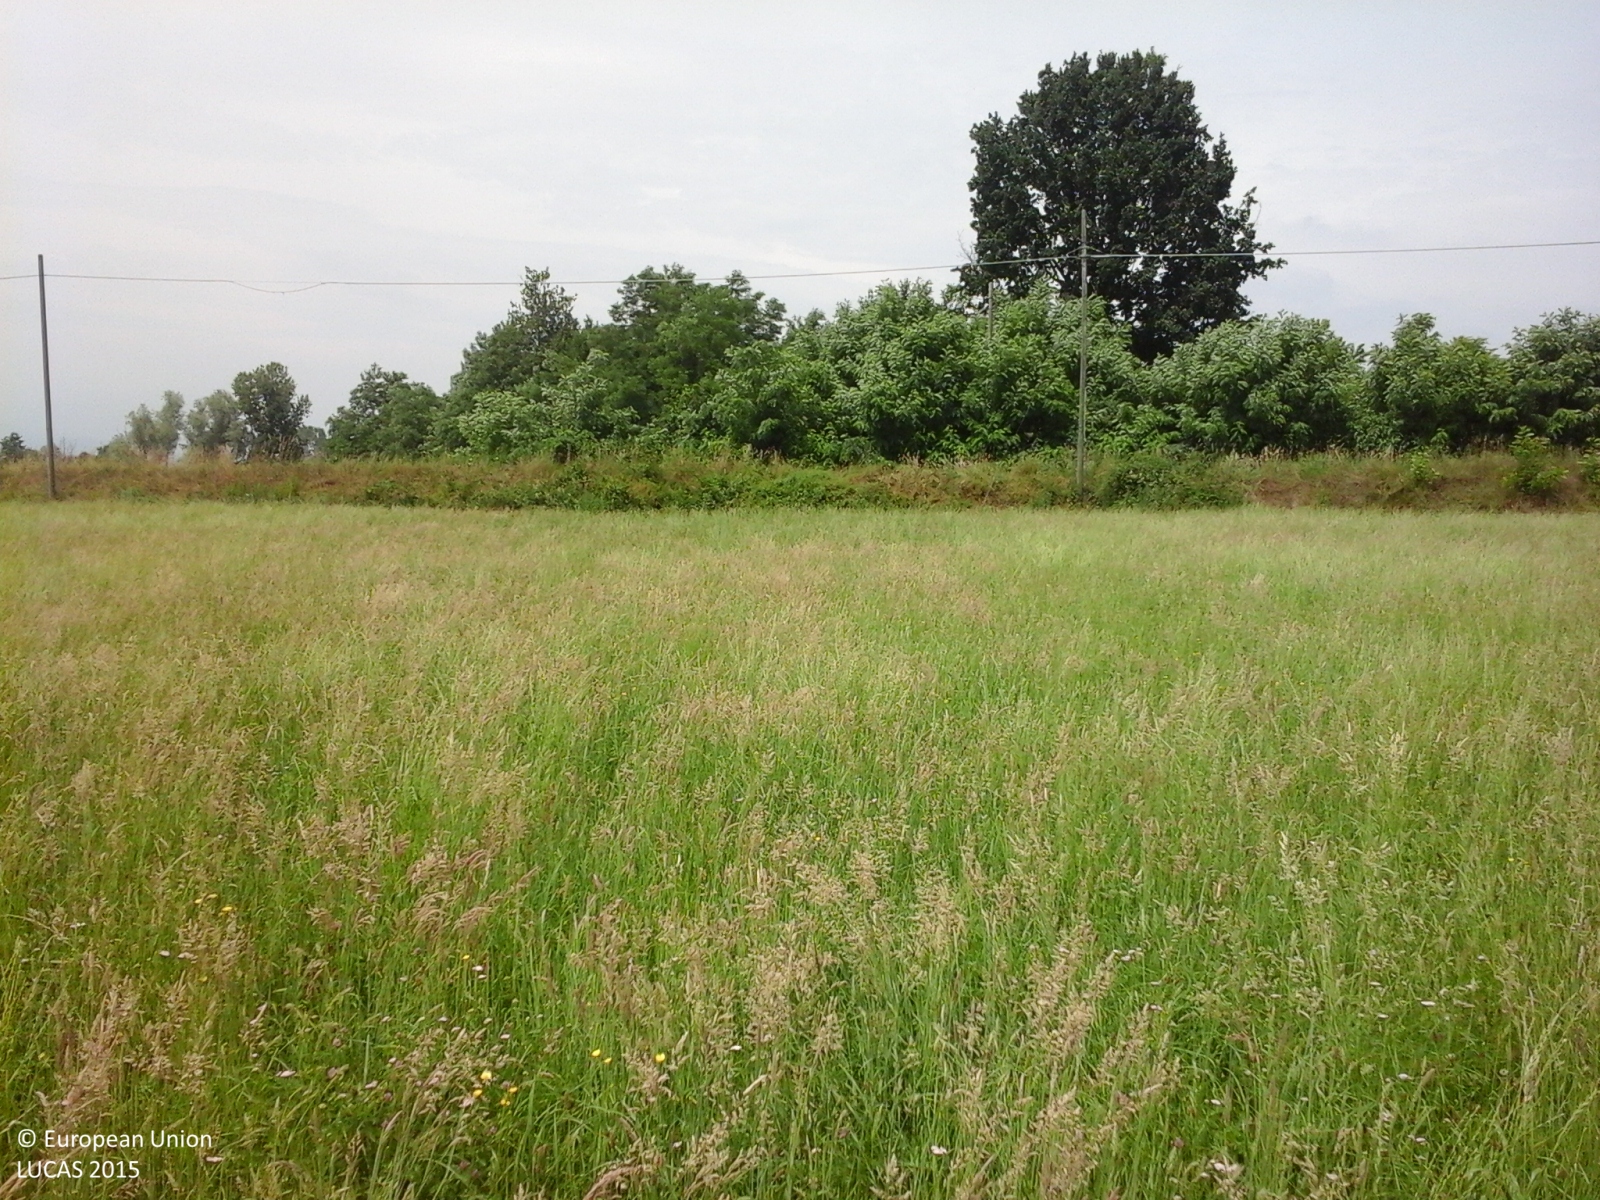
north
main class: Grassland
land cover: Grassland without tree/shrub cover
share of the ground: > 75 %
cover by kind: herbaceous plants 100 %
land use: Agriculture (excluding fallow land and kitchen gardens)
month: June
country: IT
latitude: 45.3192
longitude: 7.7967
